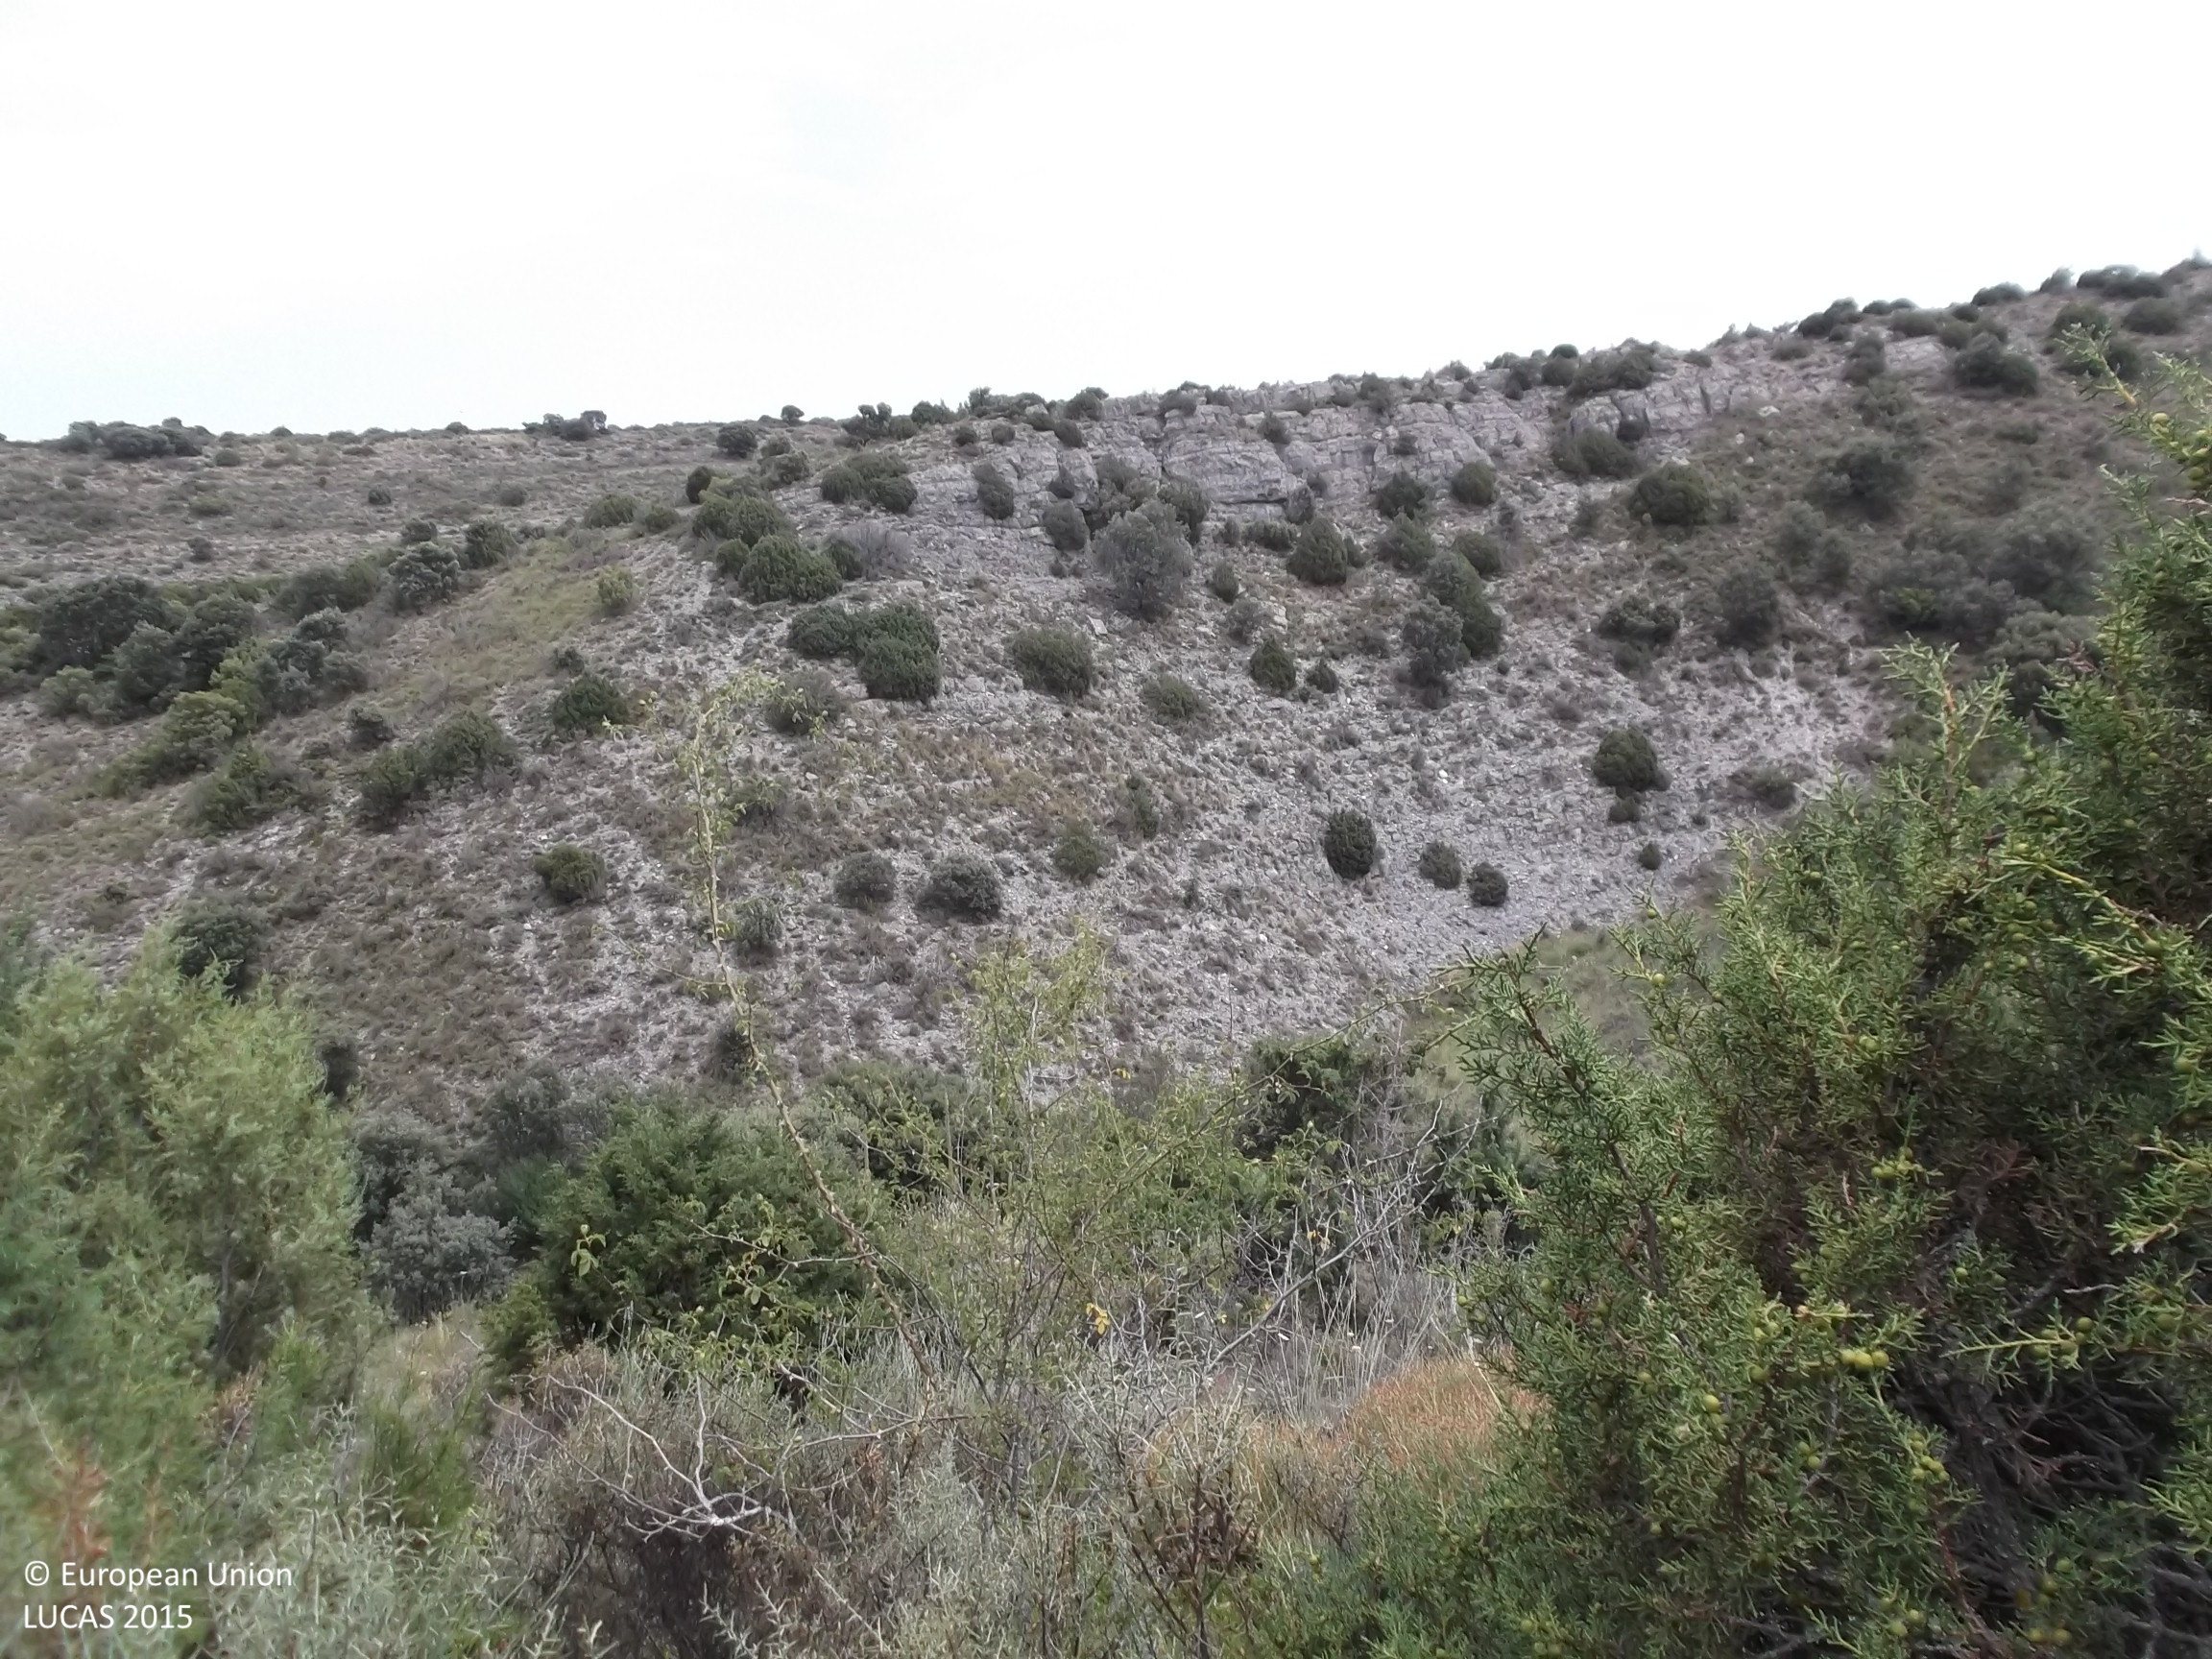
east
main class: Woodland
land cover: Other coniferous woodland
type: coniferous forest of the mediterranean region
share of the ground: 10 - 25 %
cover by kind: shrubs 70 %, coniferous forest trees 15 %, herbaceous plants 10 %, broadleaved forest trees 5 %
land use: Semi-natural and natural areas not in use
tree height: < 5 m
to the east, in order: Other coniferous woodland; Rivers and streams; Other coniferous woodland; Shrubland with sparse tree cover
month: July
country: ES
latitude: 41.9038
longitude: -1.9802
